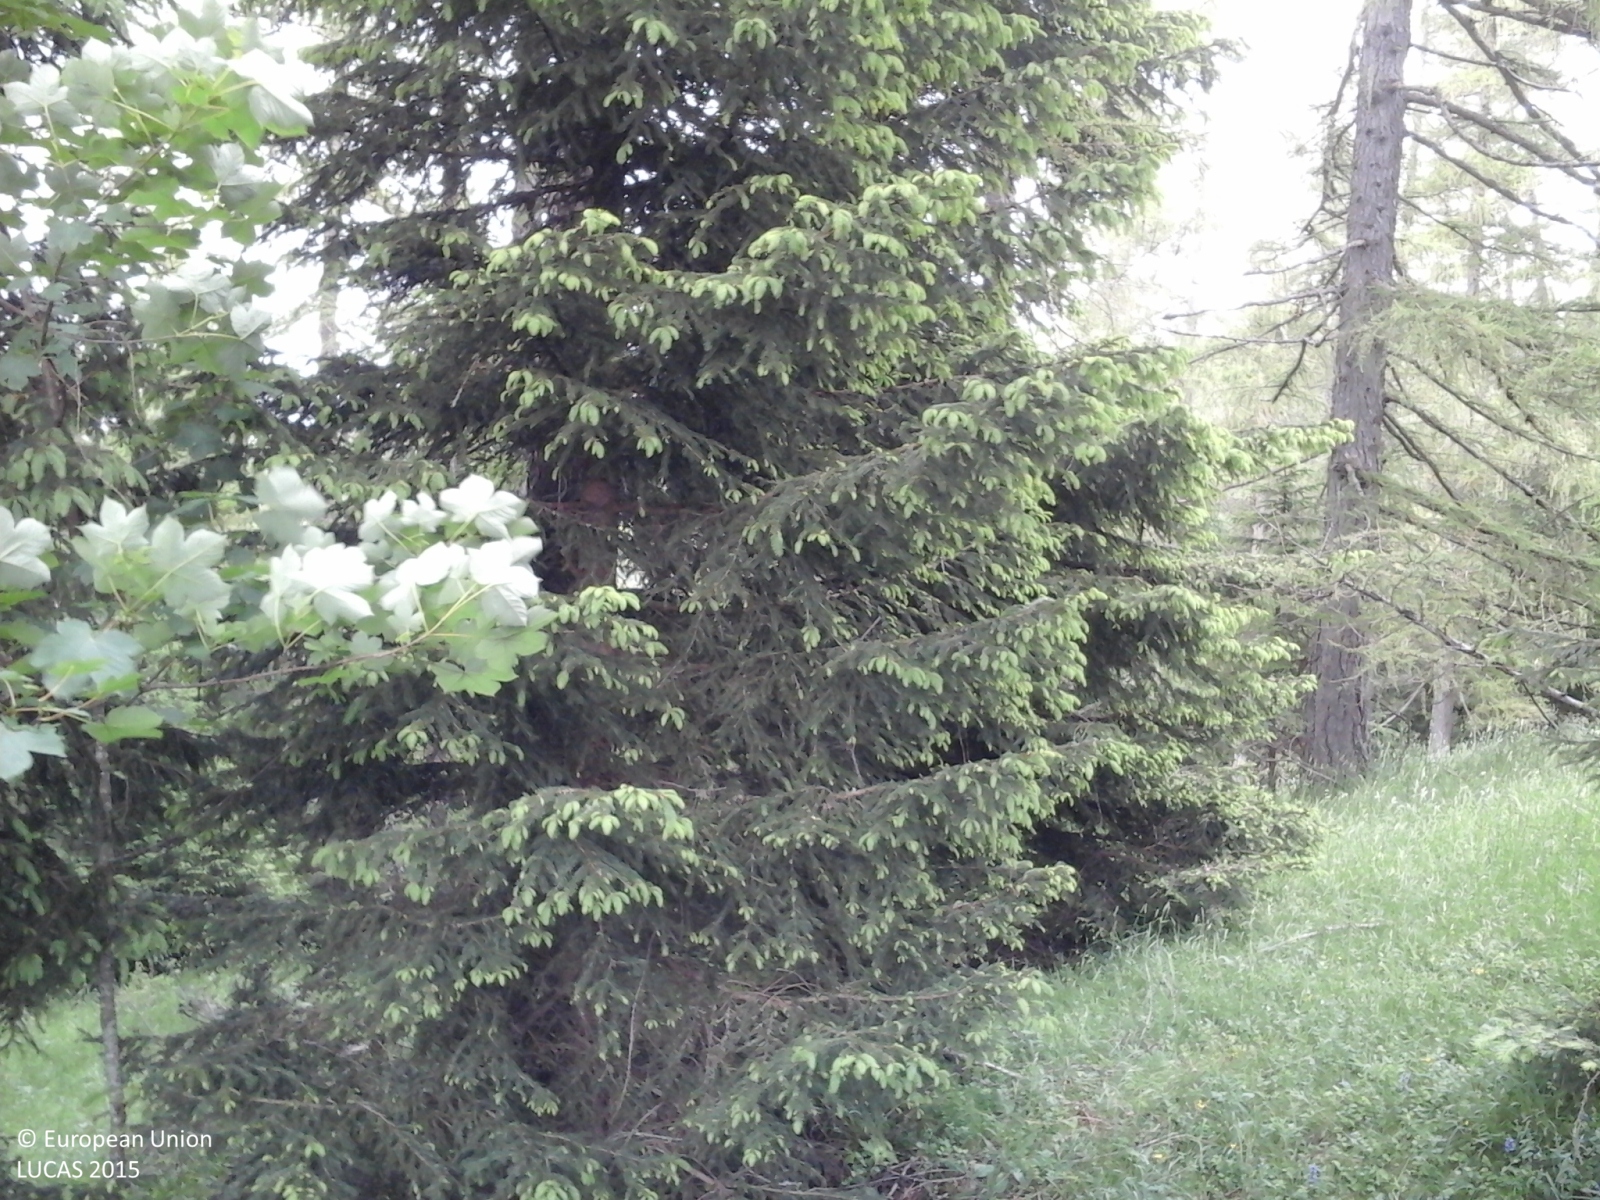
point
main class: Woodland
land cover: Spruce dominated coniferous woodland
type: alpine coniferous forest
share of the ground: > 75 %
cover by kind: coniferous forest trees 100 %
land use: Forestry
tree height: > 5 m
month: June
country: IT
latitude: 45.8944
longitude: 11.1710
